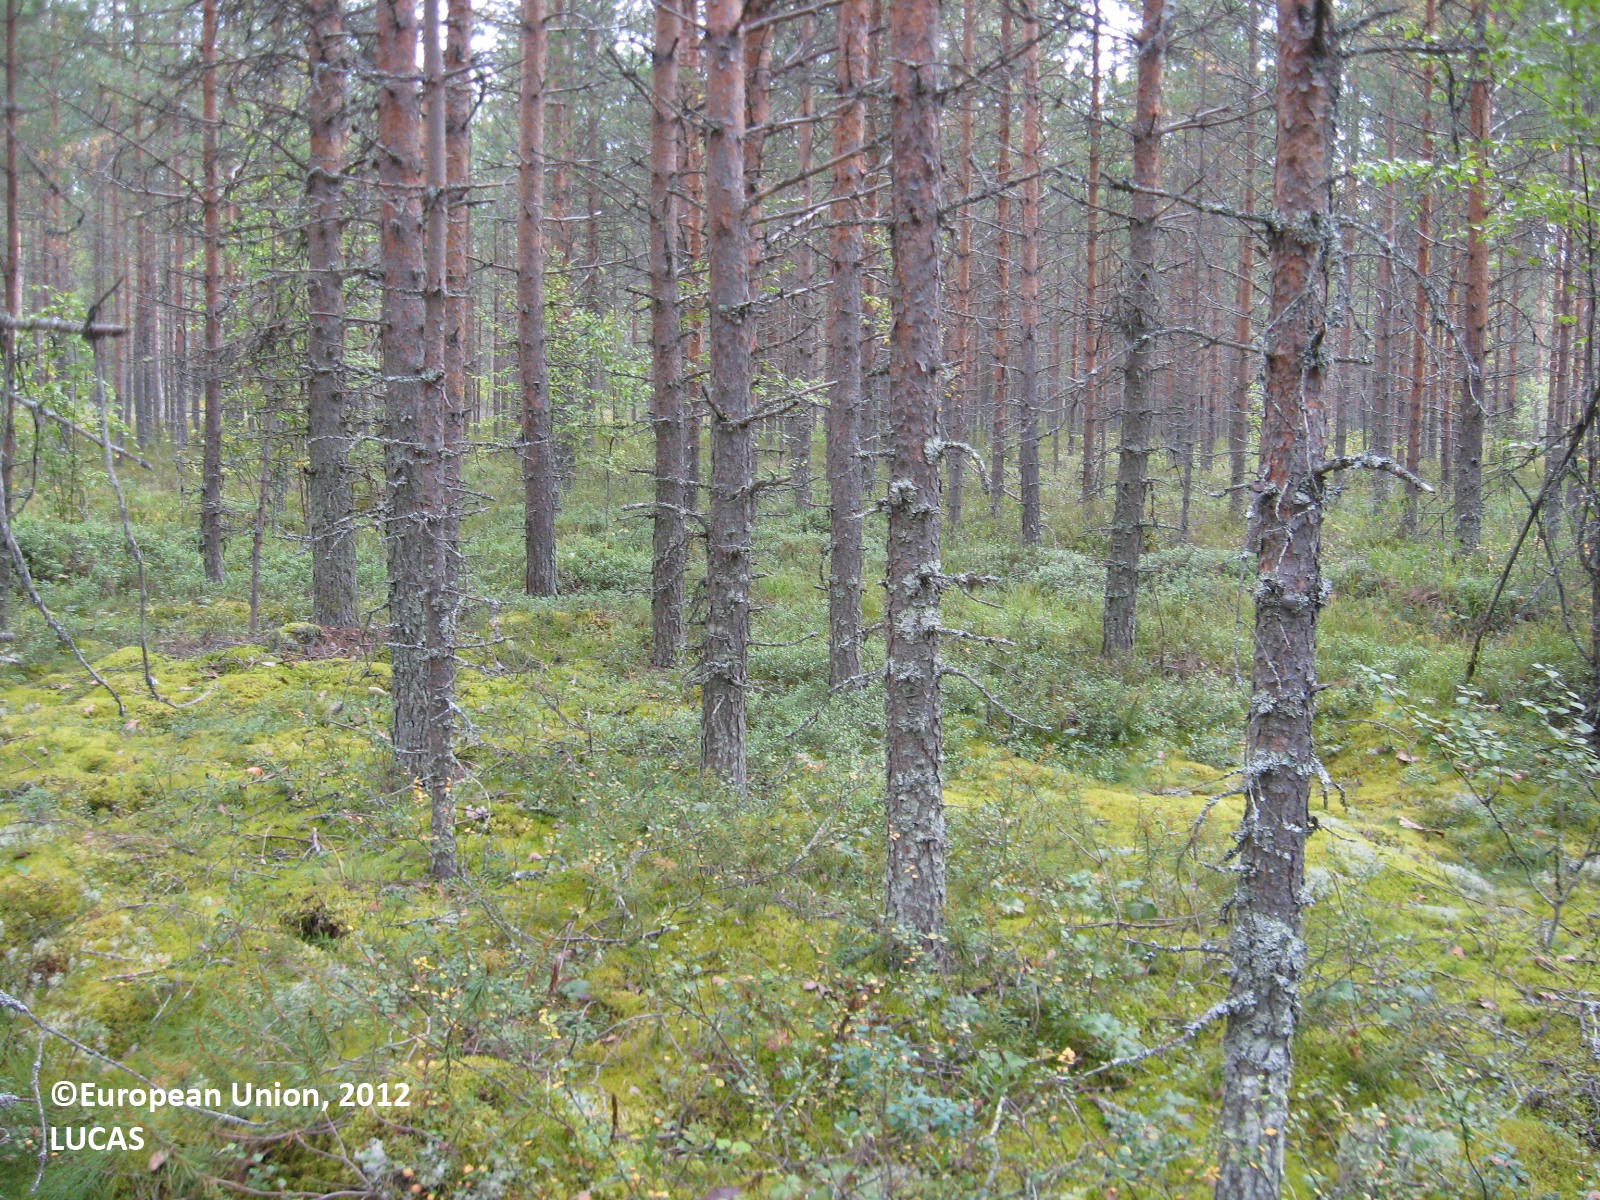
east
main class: Woodland
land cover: Pine dominated coniferous woodland
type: boreal forest
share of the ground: > 75 %
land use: Forestry
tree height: > 5 m
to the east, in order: Pine dominated coniferous woodland; Ditches and canals; Pine dominated coniferous woodland; Pine dominated mixed woodland; Ditches and canals; Pine dominated coniferous woodland
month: August
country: FI
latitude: 63.4472
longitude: 30.0824
